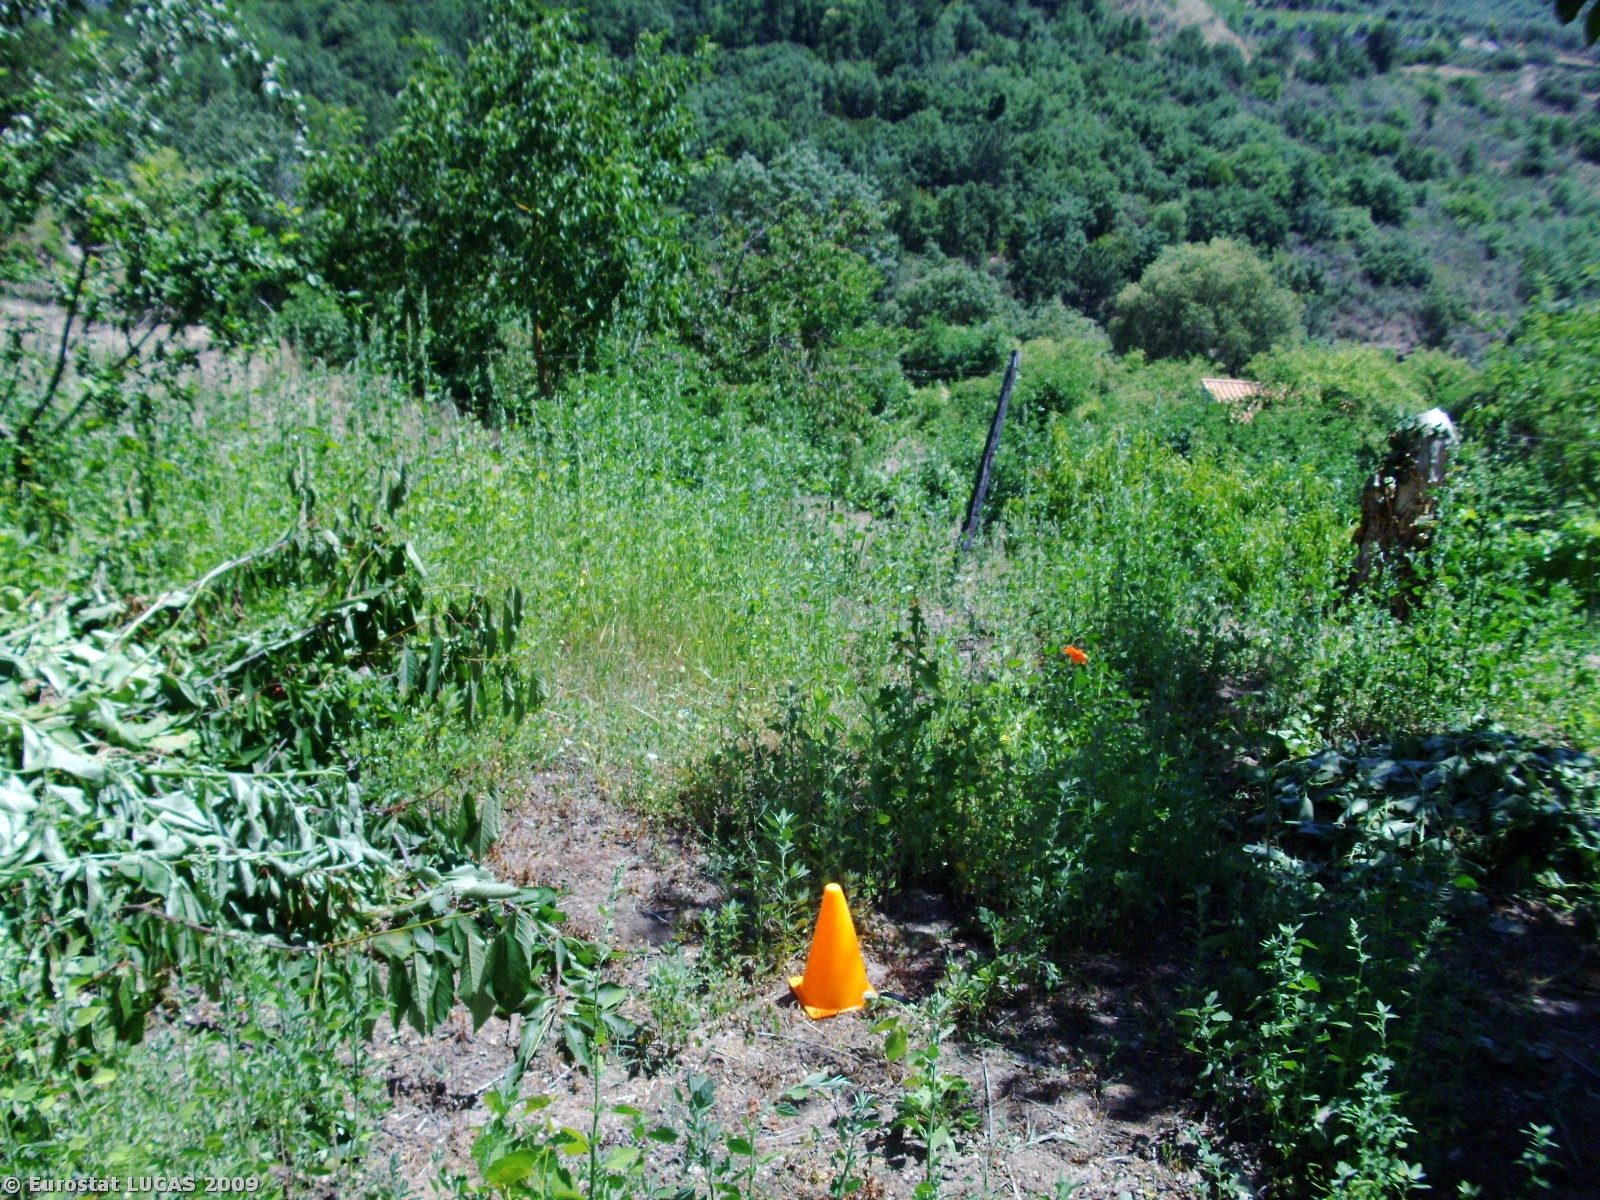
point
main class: Cropland
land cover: Nuts trees
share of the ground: > 75 %
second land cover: Spontaneously vegetated surfaces
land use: Agriculture (excluding fallow land and kitchen gardens)
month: July
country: PT
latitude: 41.0533
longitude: -7.7477
